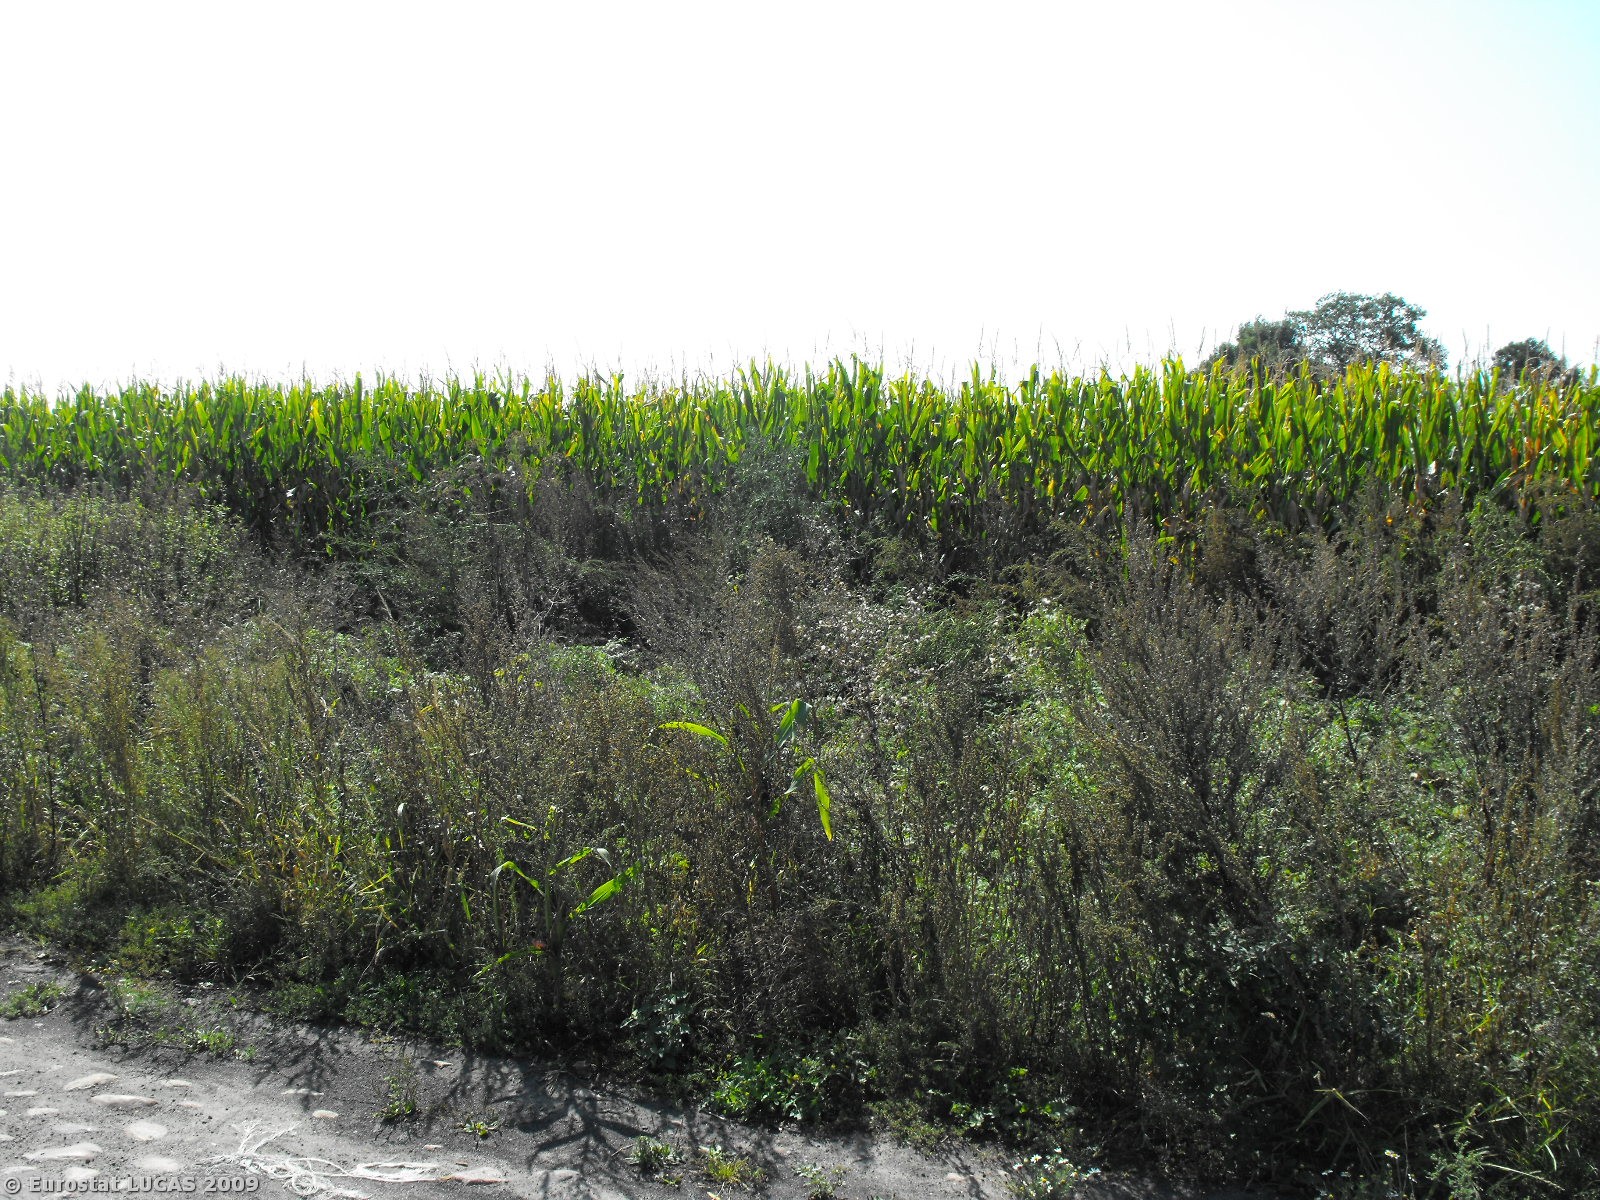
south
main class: Cropland
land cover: Maize
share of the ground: > 75 %
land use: Agriculture (excluding fallow land and kitchen gardens)
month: September
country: PL
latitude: 52.3689
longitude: 16.3665
